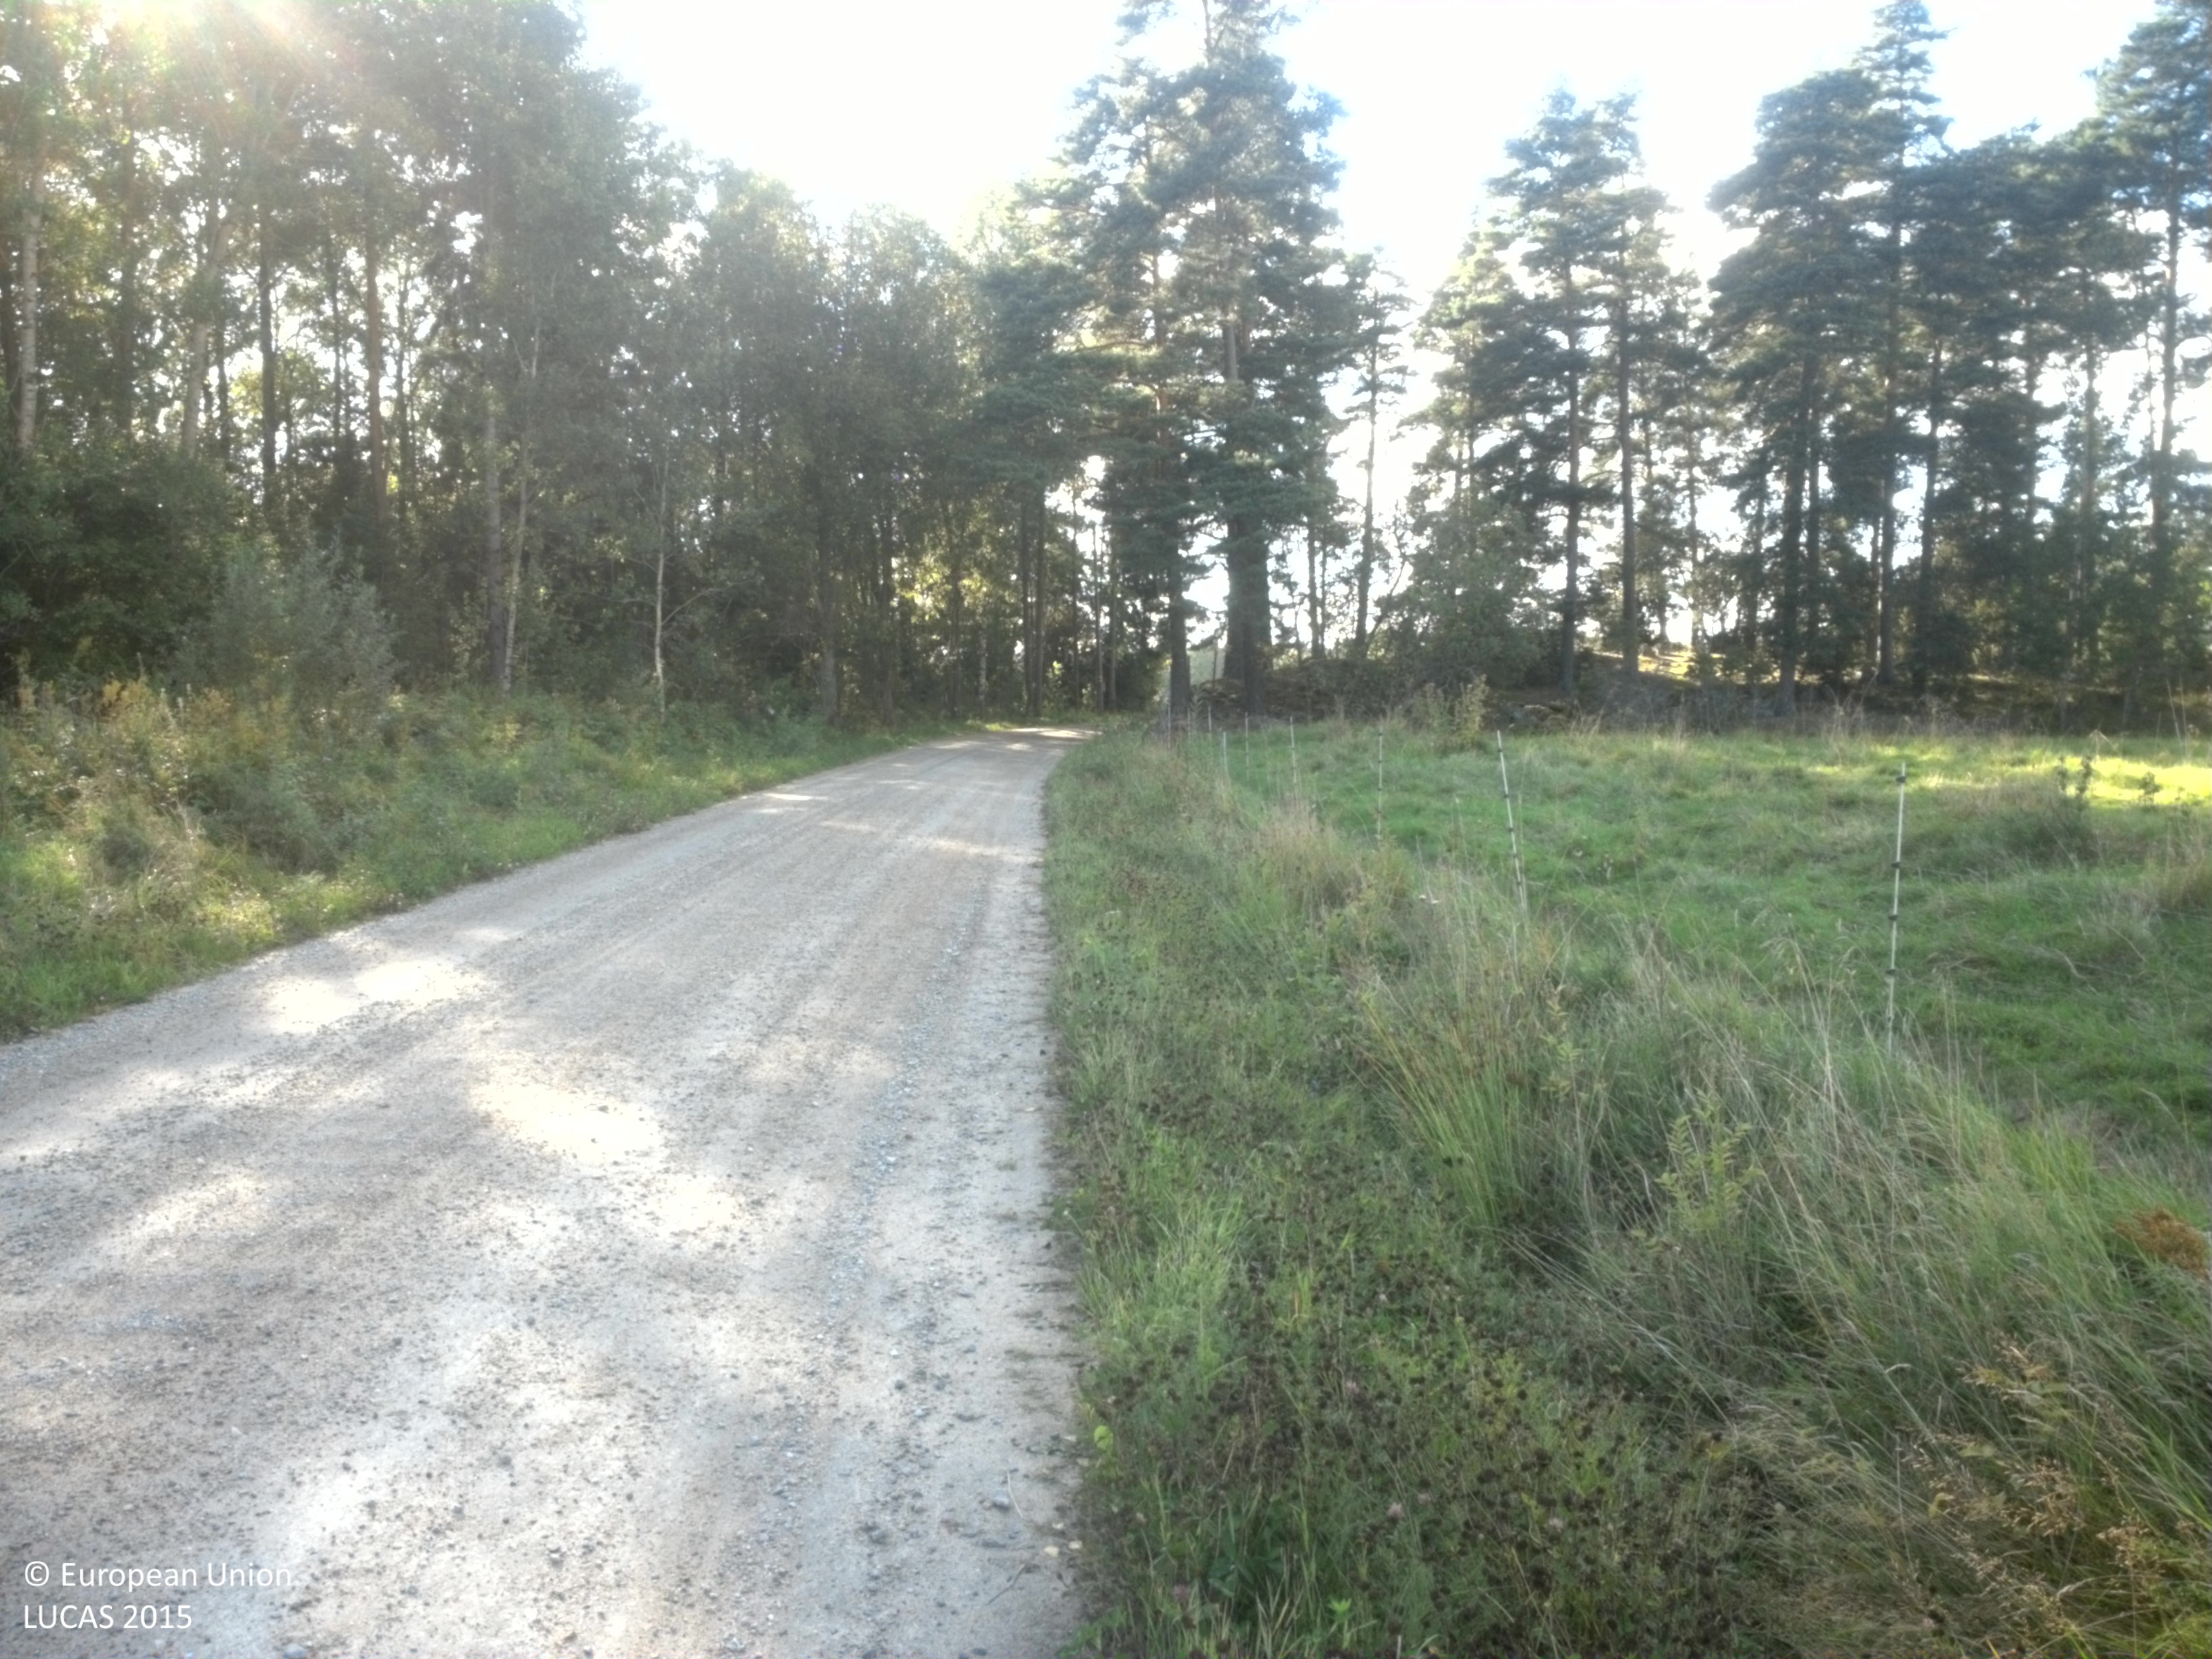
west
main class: Grassland
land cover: Grassland without tree/shrub cover
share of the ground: > 75 %
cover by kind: herbaceous plants 100 %
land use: Agriculture (excluding fallow land and kitchen gardens)
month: August
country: SE
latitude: 59.4358
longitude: 15.6509
